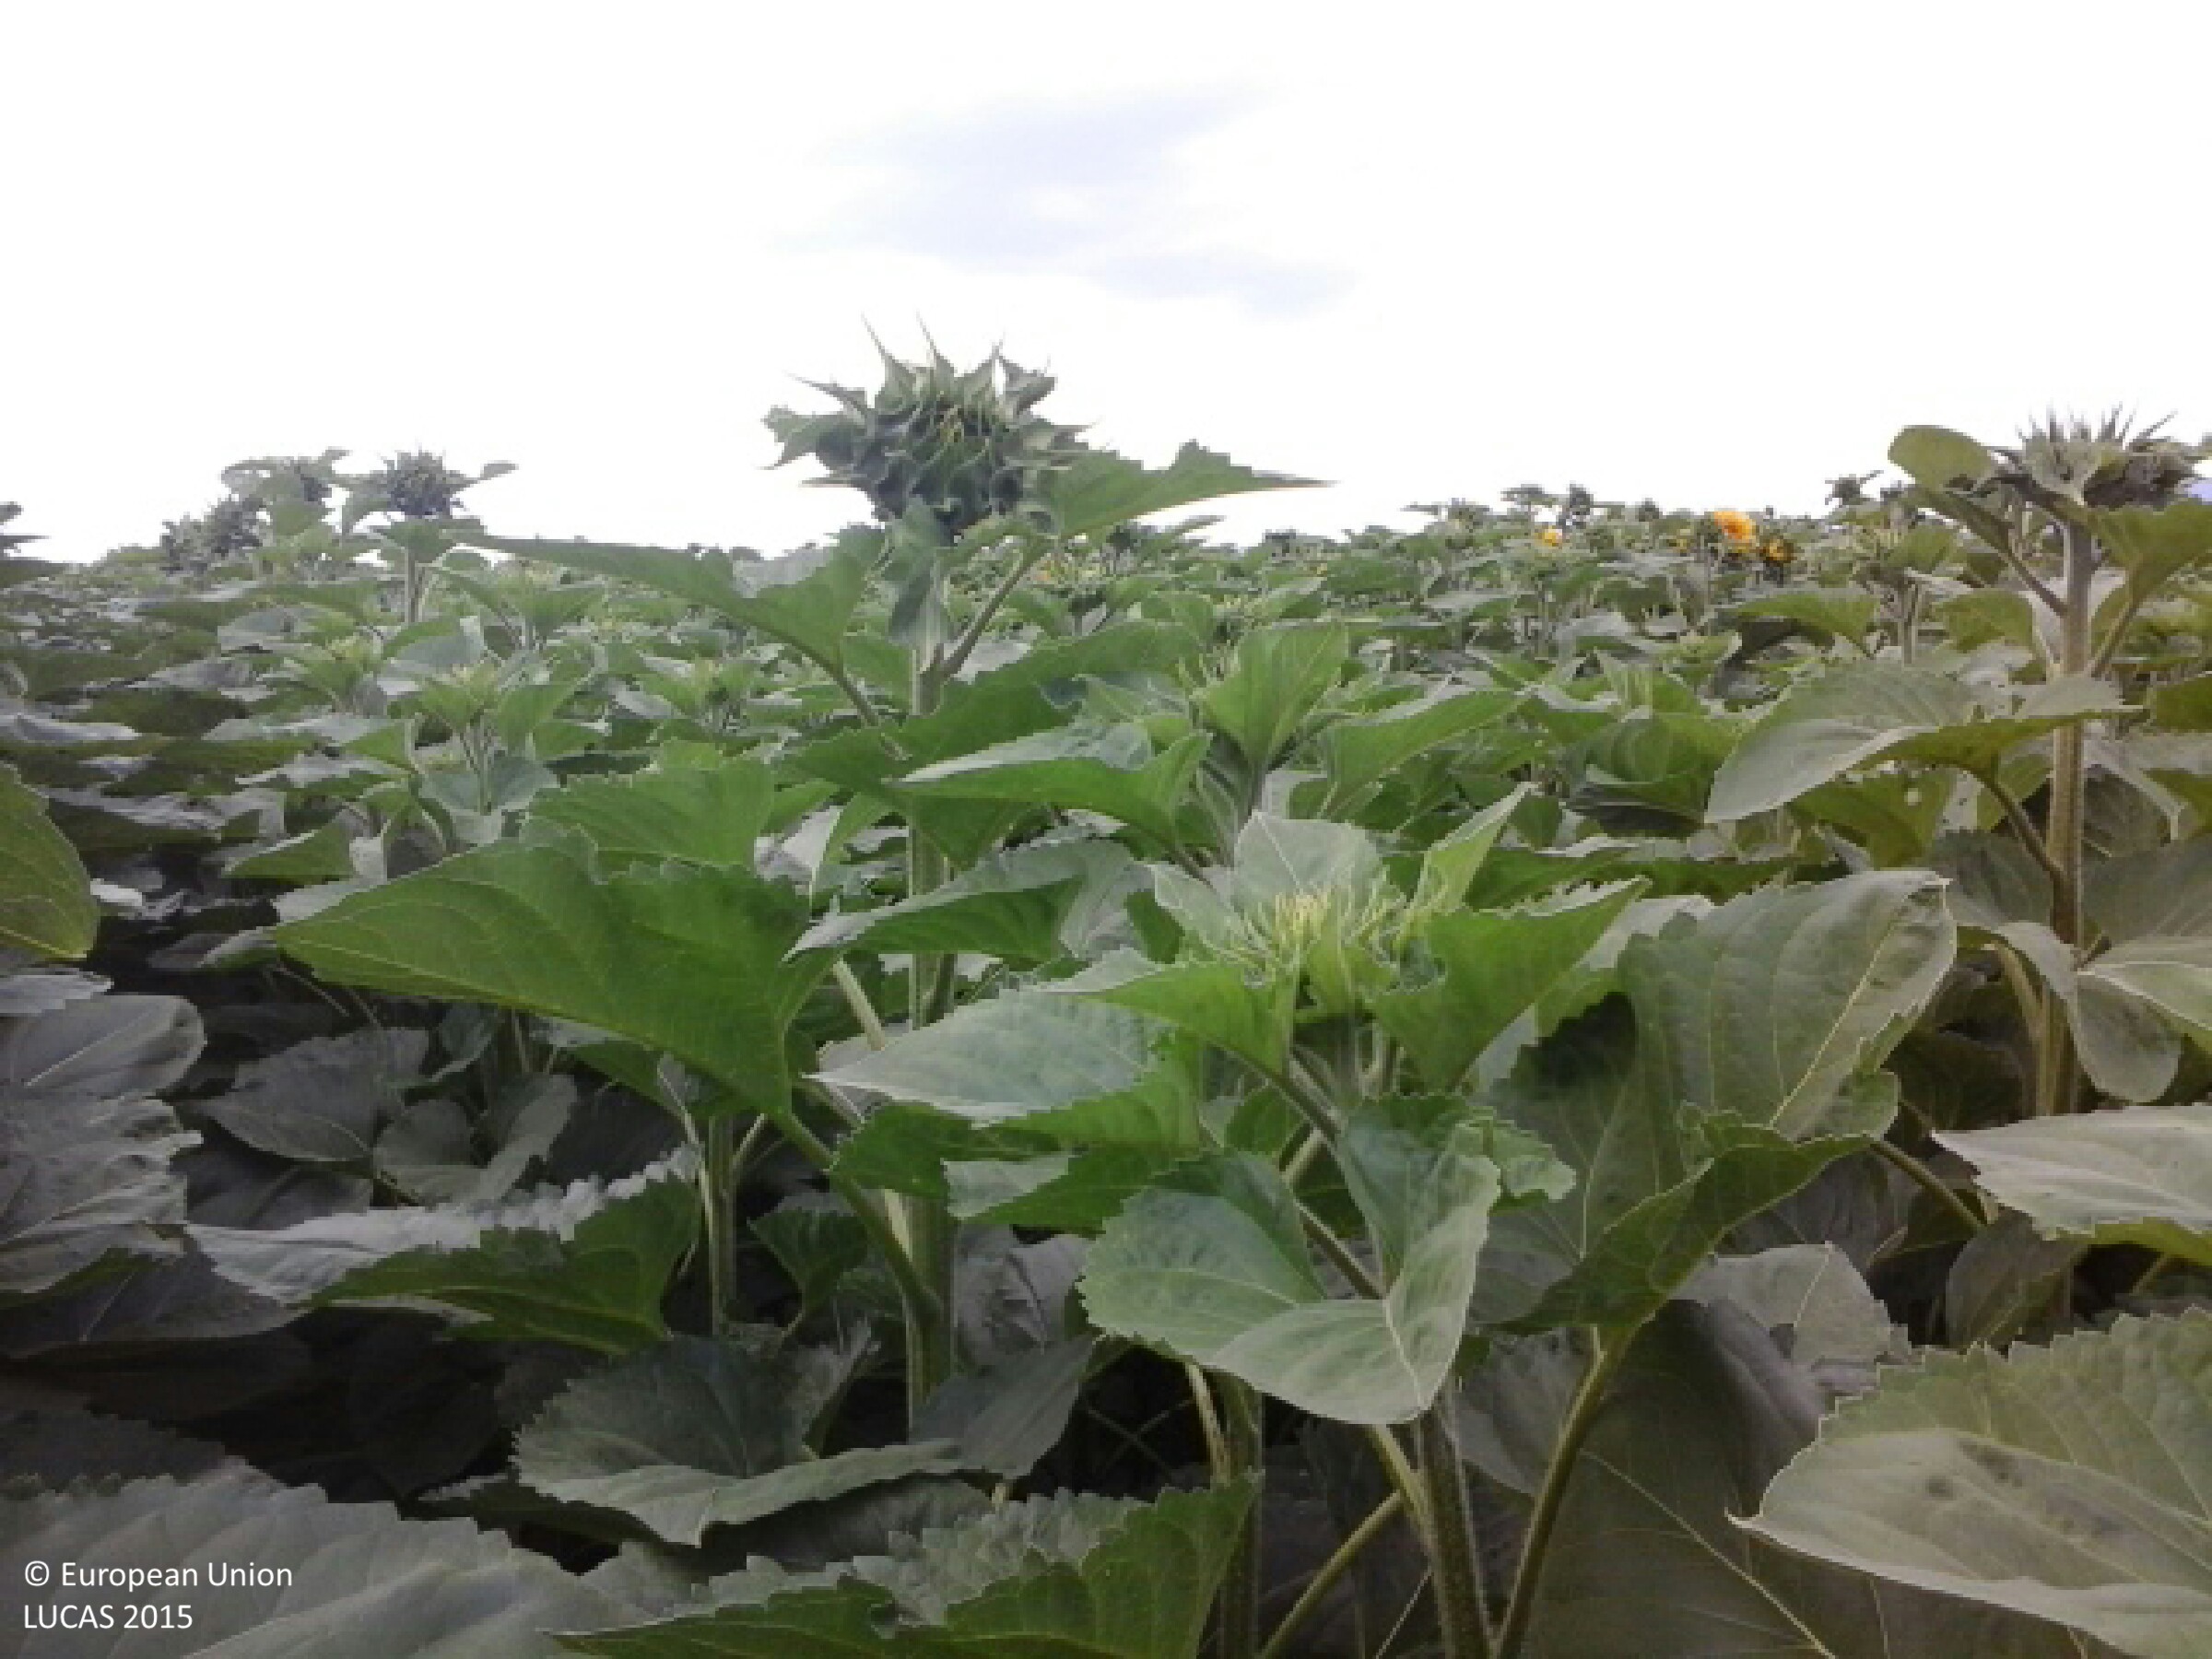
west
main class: Cropland
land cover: Sunflower
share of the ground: > 75 %
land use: Agriculture (excluding fallow land and kitchen gardens)
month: June
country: HU
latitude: 47.7779
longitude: 19.8884
